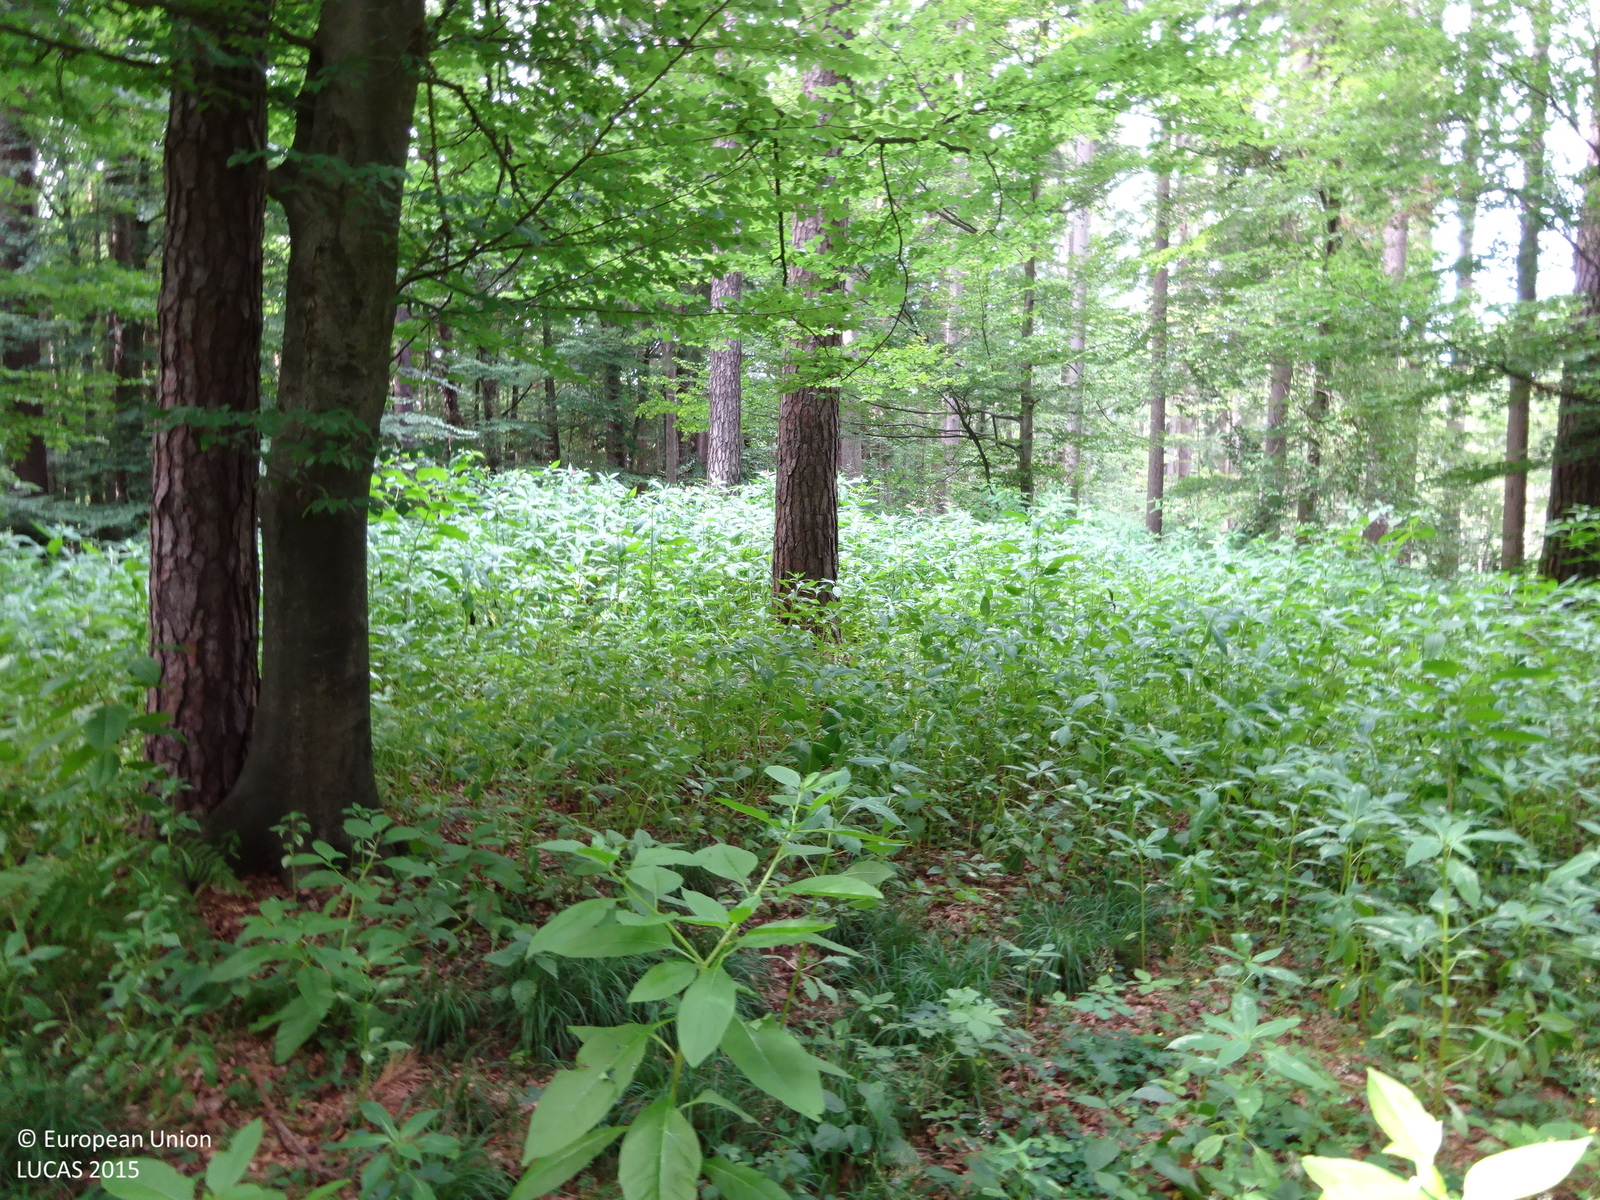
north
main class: Woodland
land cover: Other mixed woodland
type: hemiboreal forest and nemoral coniferous forest and mixed broadleaved-coniferous forest
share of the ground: > 75 %
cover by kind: broadleaved forest trees 65 %, coniferous forest trees 25 %, herbaceous plants 10 %
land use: Forestry
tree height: > 5 m
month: July
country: AT
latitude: 46.9009
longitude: 15.3946
